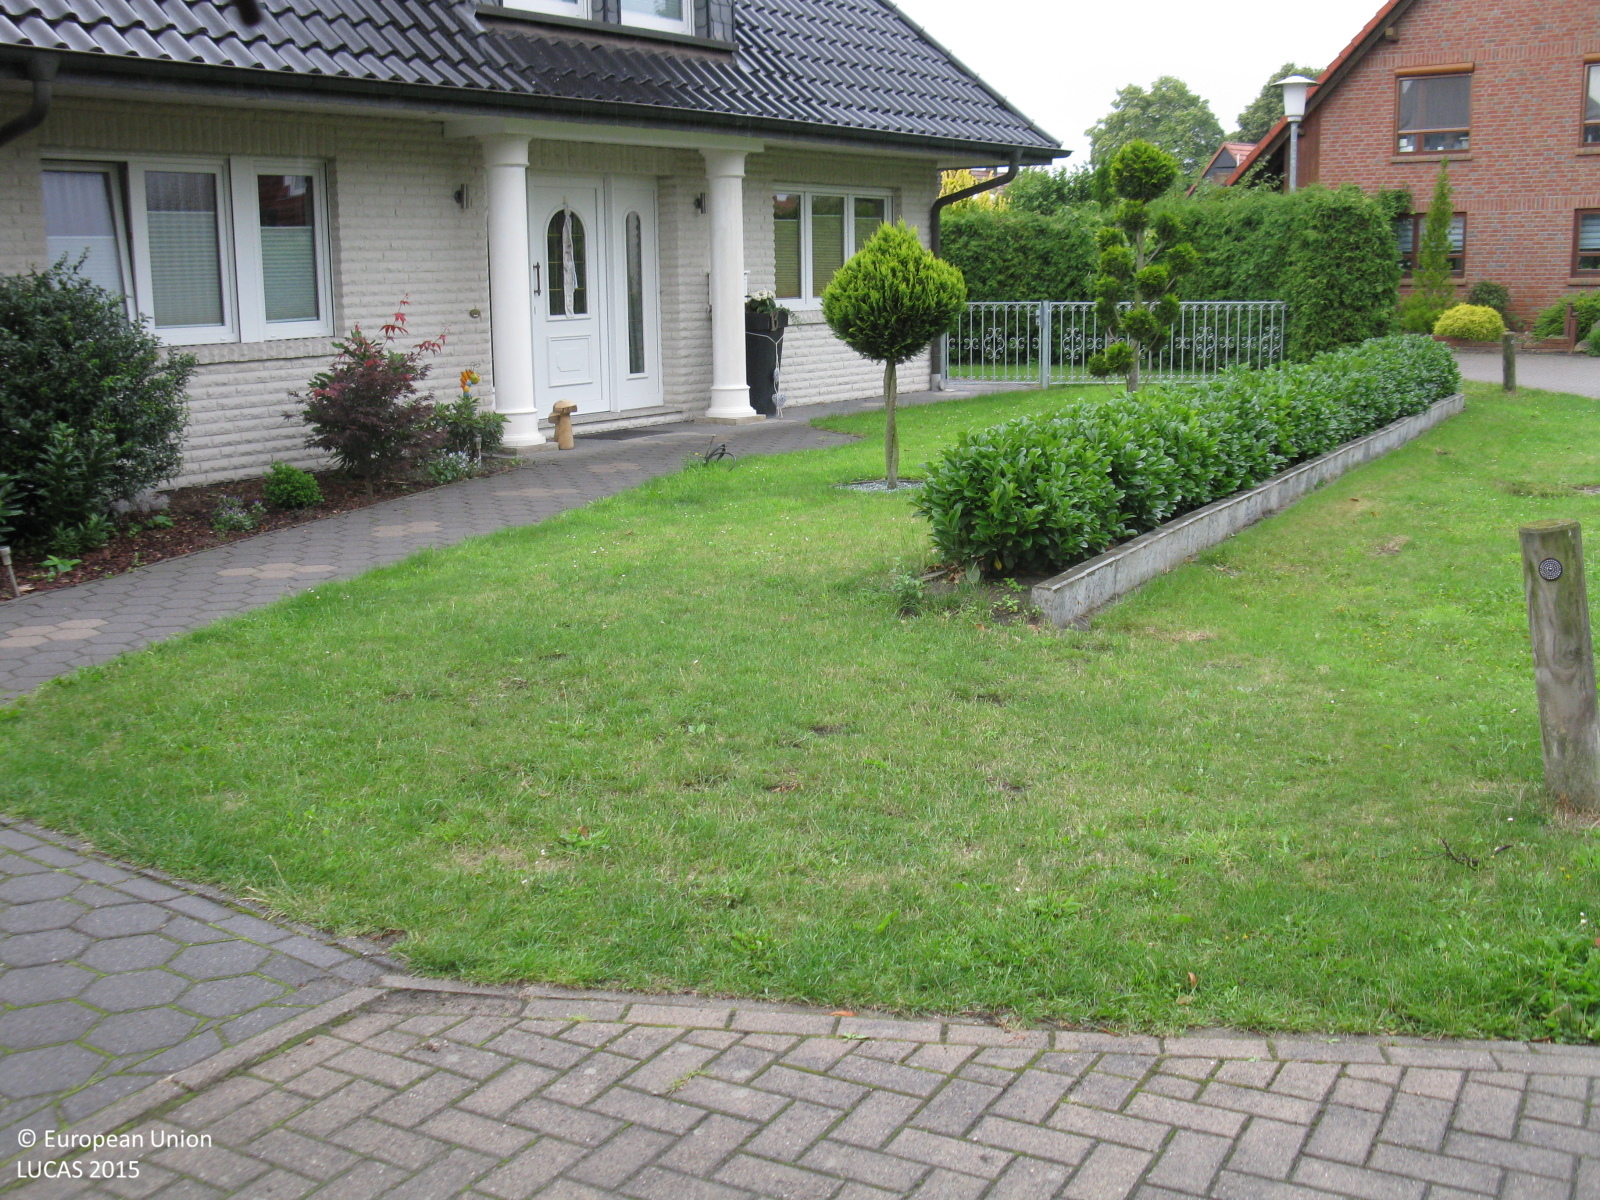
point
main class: Grassland
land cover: Grassland with sparse tree/shrub cover
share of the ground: > 75 %
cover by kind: herbaceous plants 95 %, broadleaved forest trees 5 %
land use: Residential
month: July
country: DE
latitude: 53.0881
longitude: 8.5821
